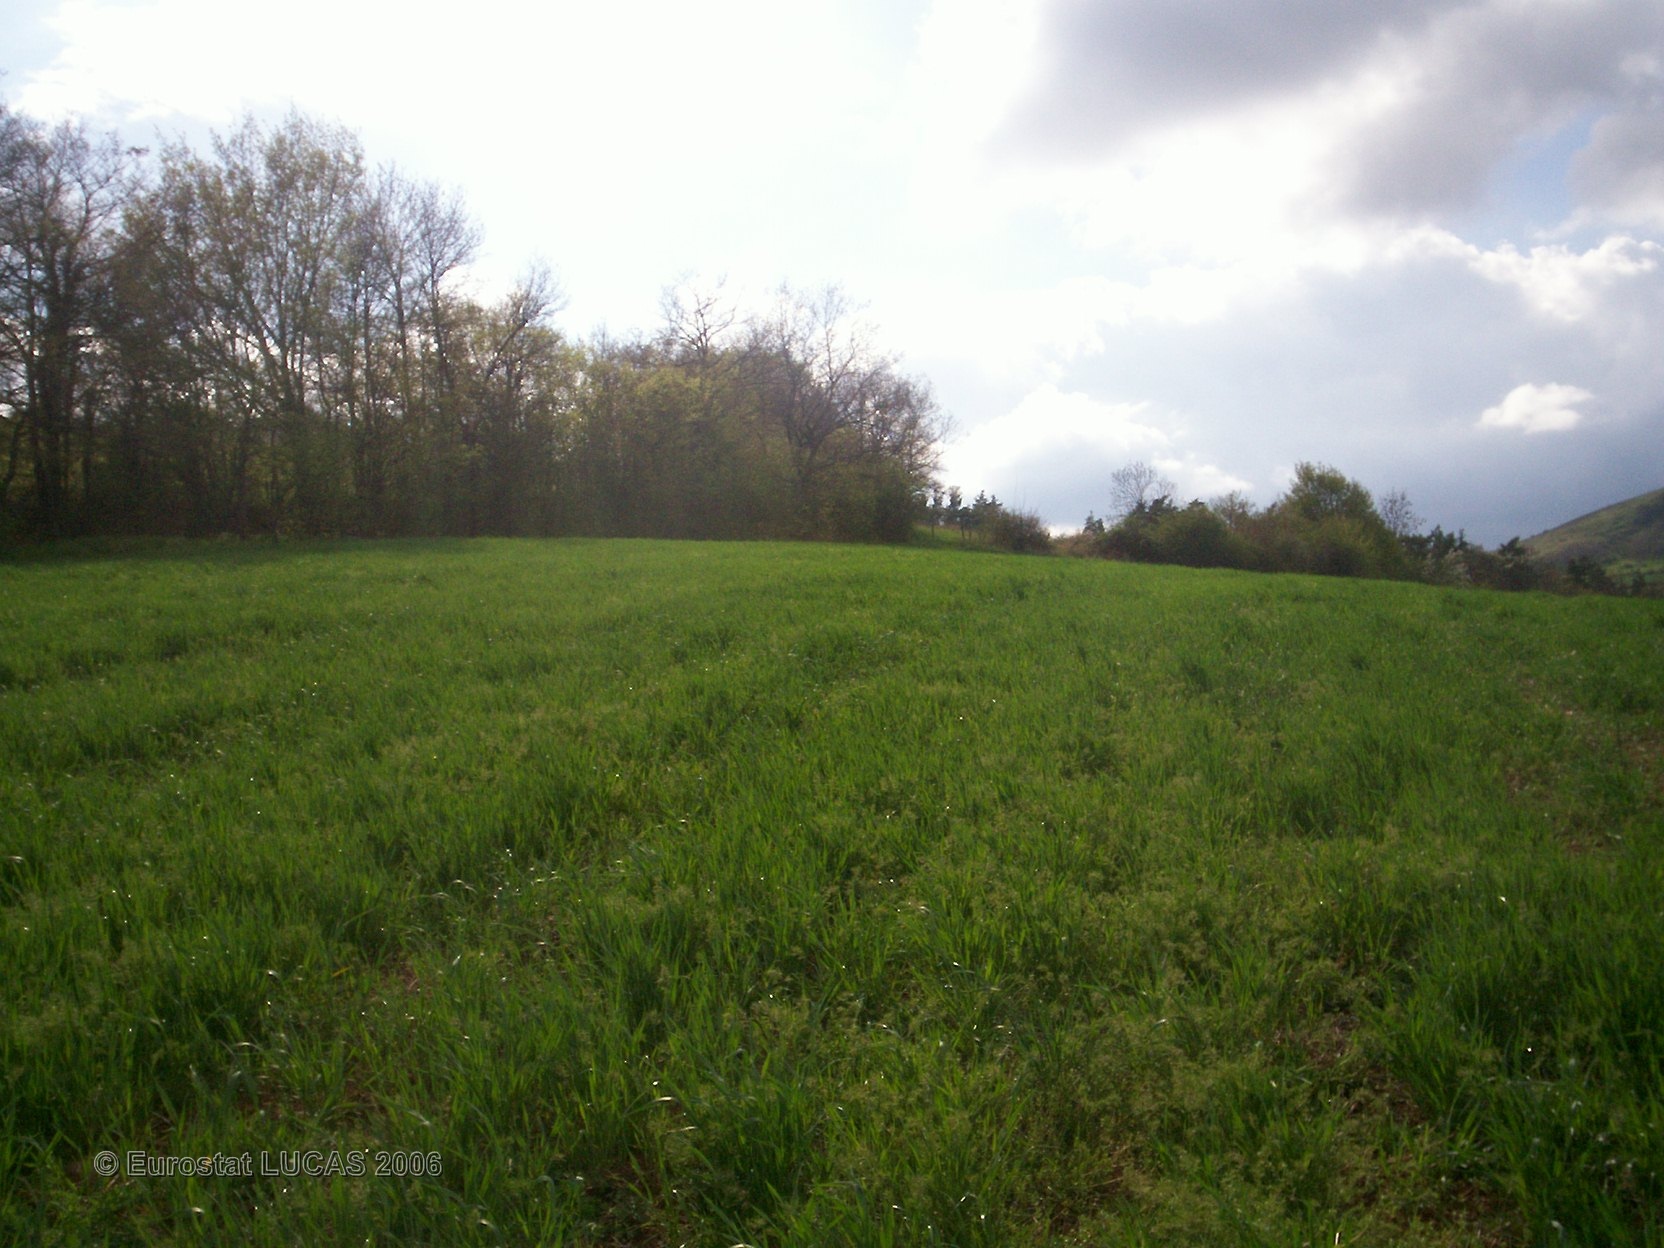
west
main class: Grassland
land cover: Grassland without tree/shrub cover
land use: Agriculture (excluding fallow land and kitchen gardens)
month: April
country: FR
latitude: 45.4273
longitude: 3.1631
